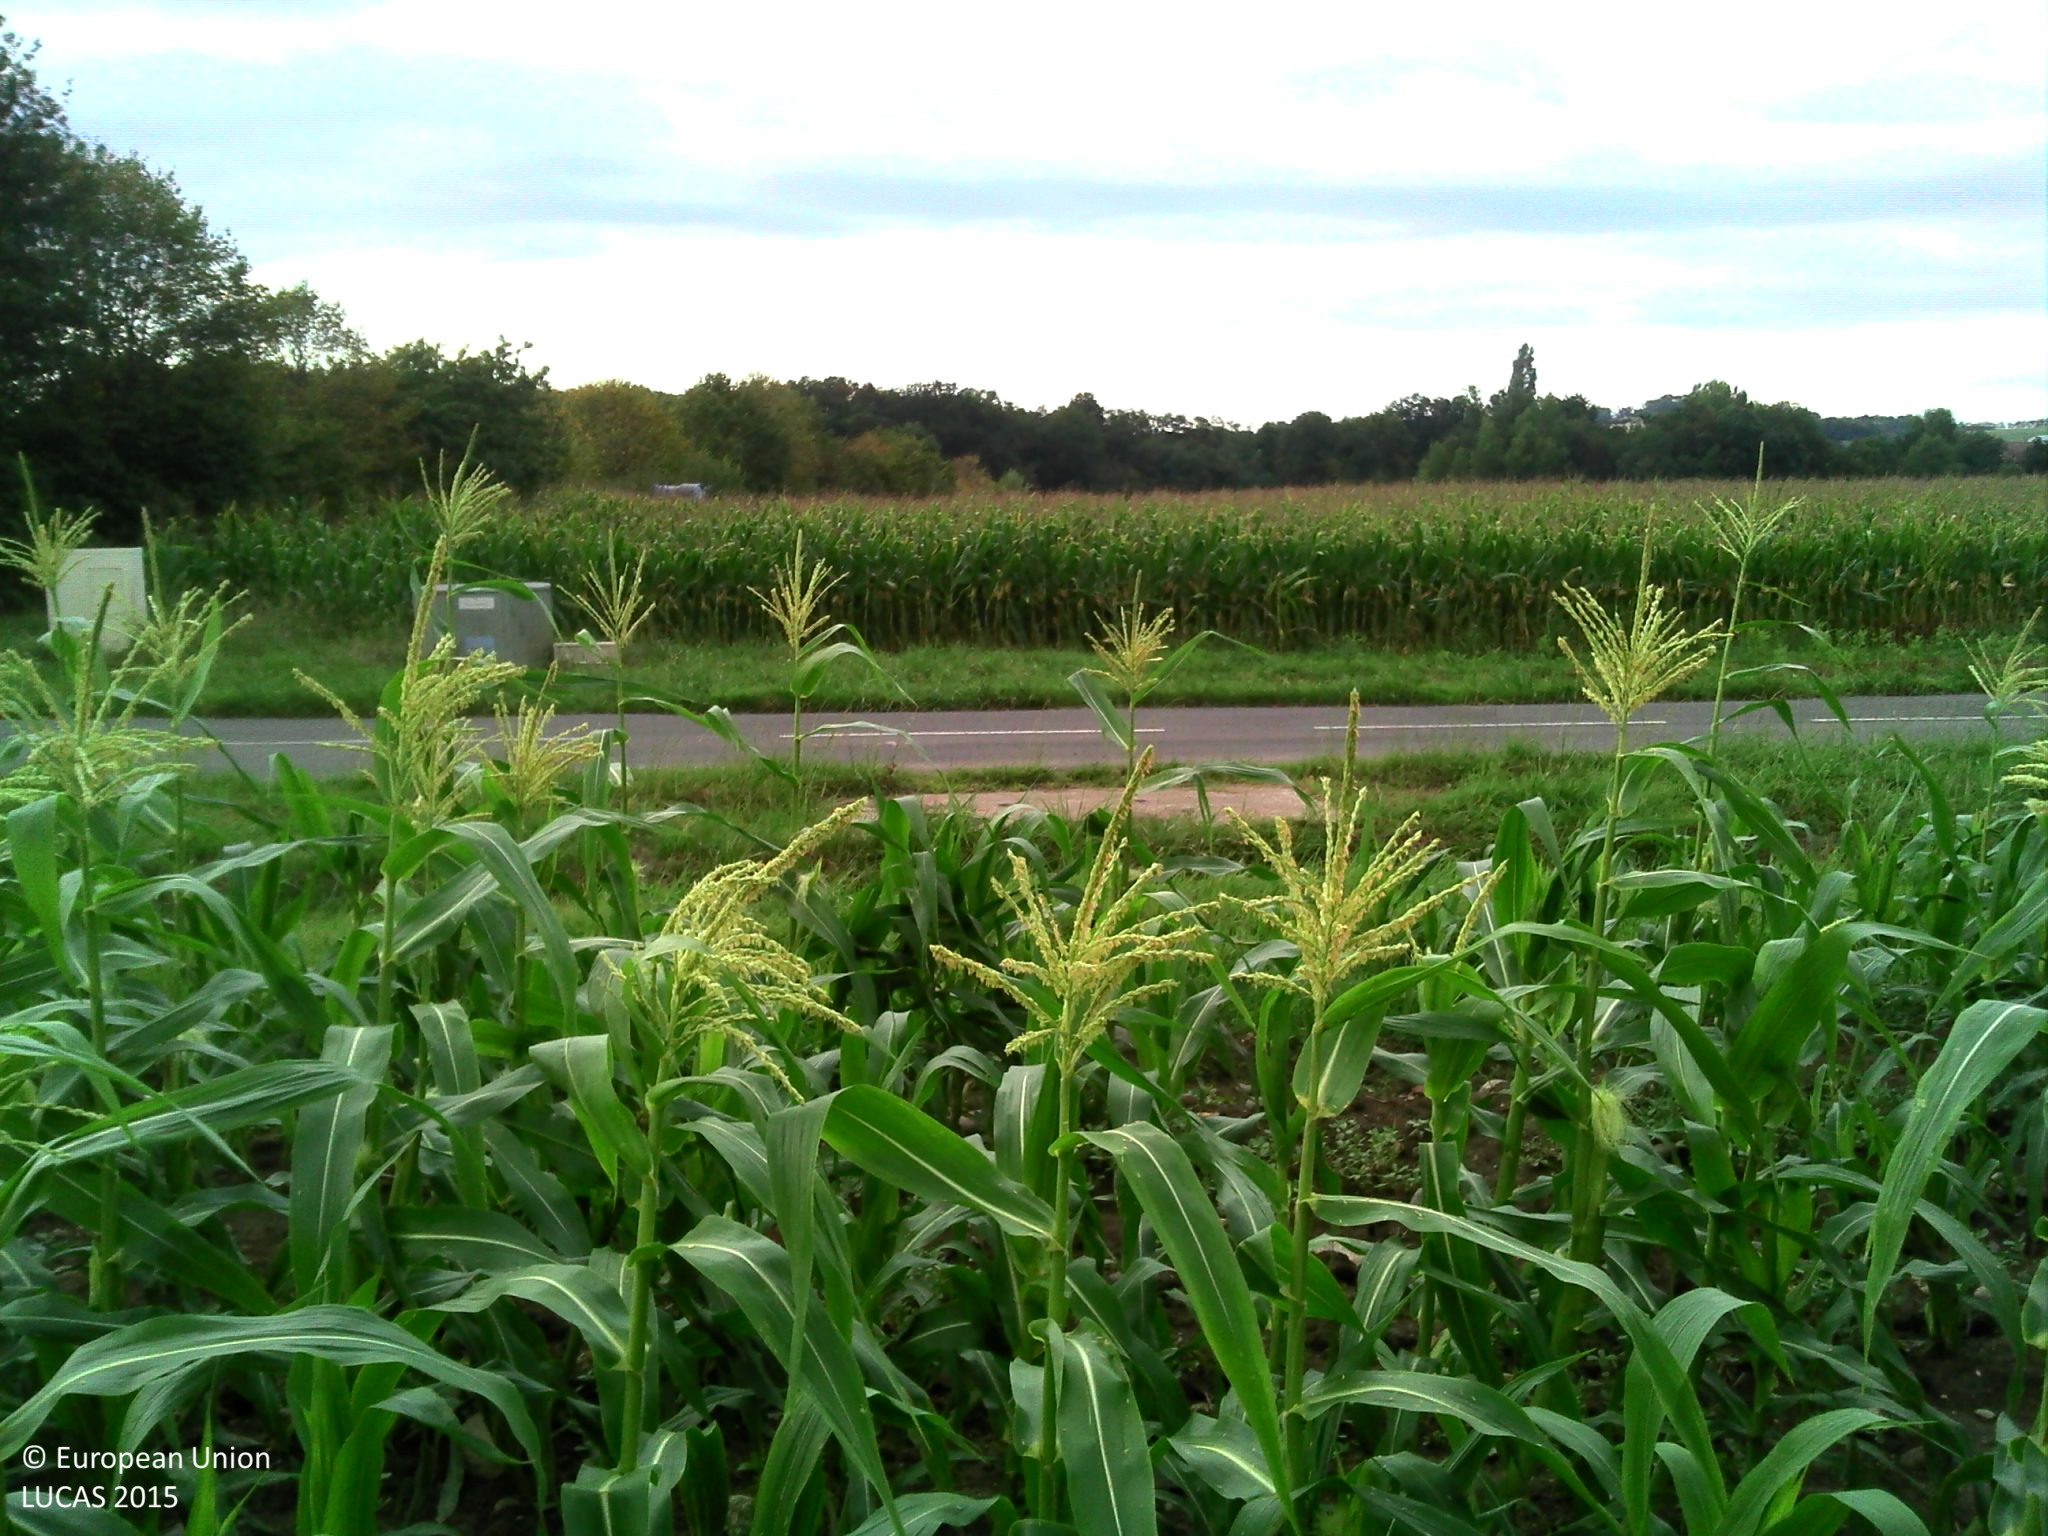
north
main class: Cropland
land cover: Maize
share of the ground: > 75 %
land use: Agriculture (excluding fallow land and kitchen gardens)
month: September
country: FR
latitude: 43.4067
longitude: -0.4177
